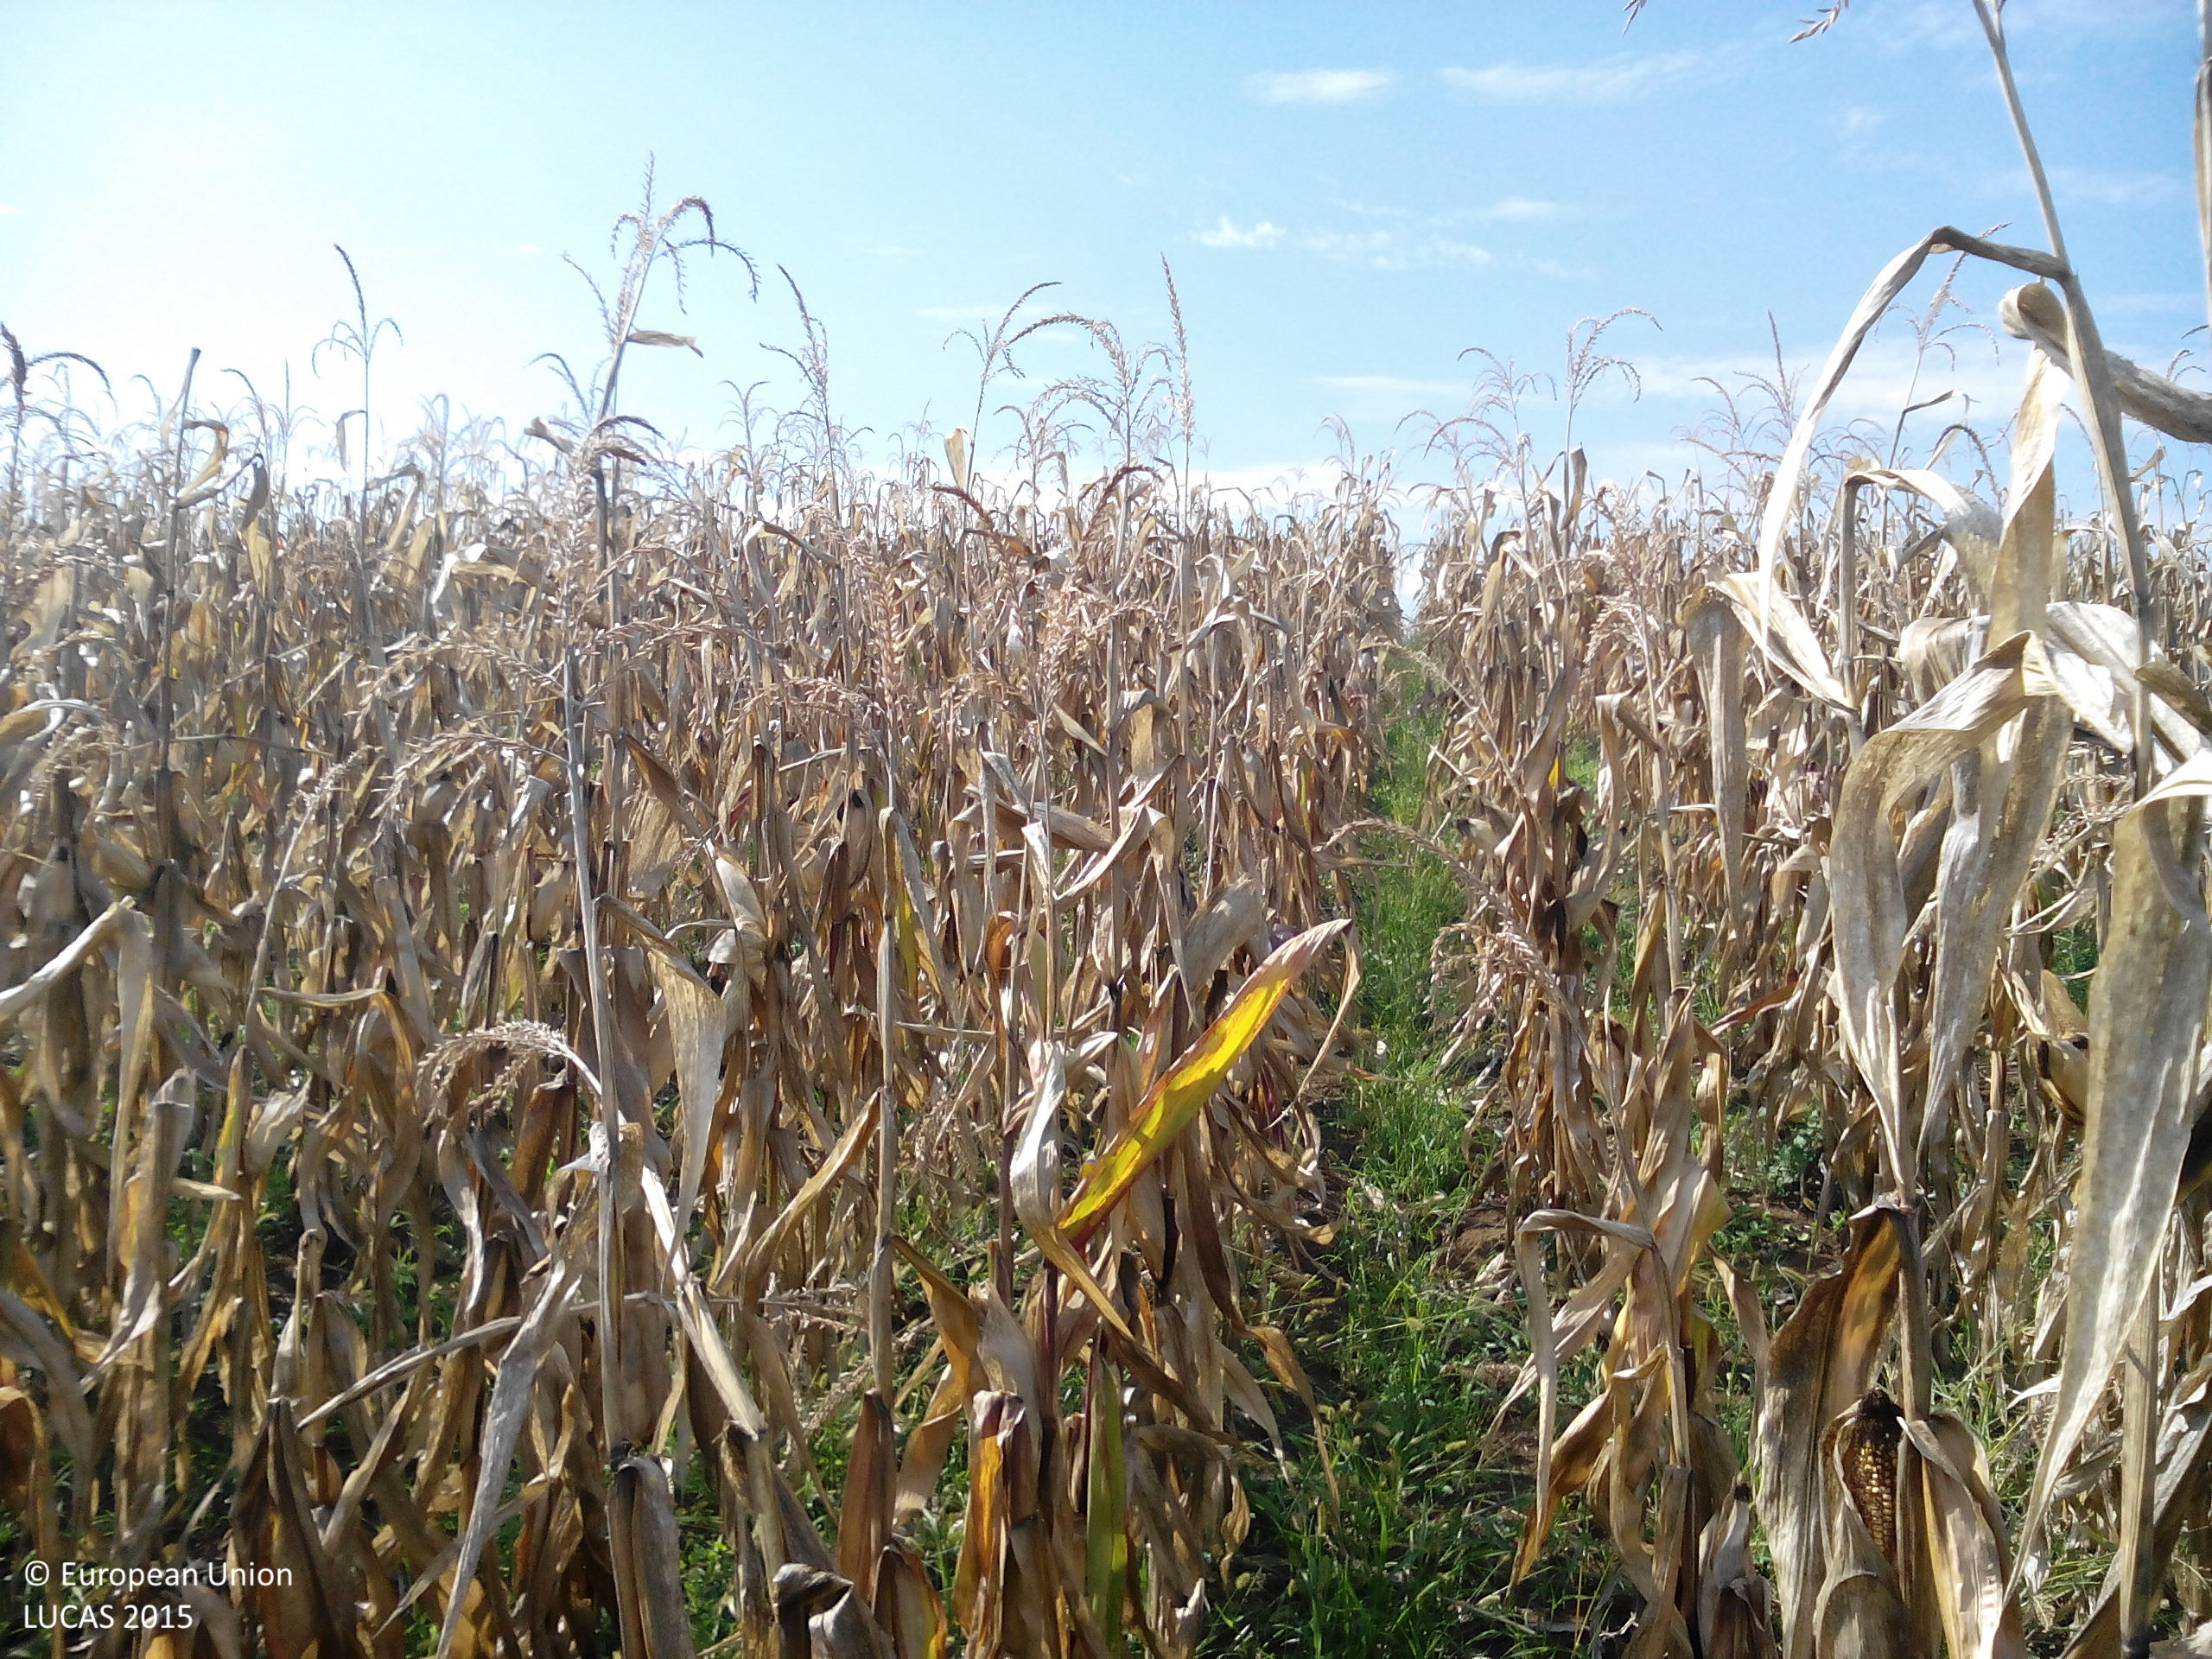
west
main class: Cropland
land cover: Maize
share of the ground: > 75 %
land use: Agriculture (excluding fallow land and kitchen gardens)
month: October
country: BG
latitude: 43.3485
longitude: 23.6781
